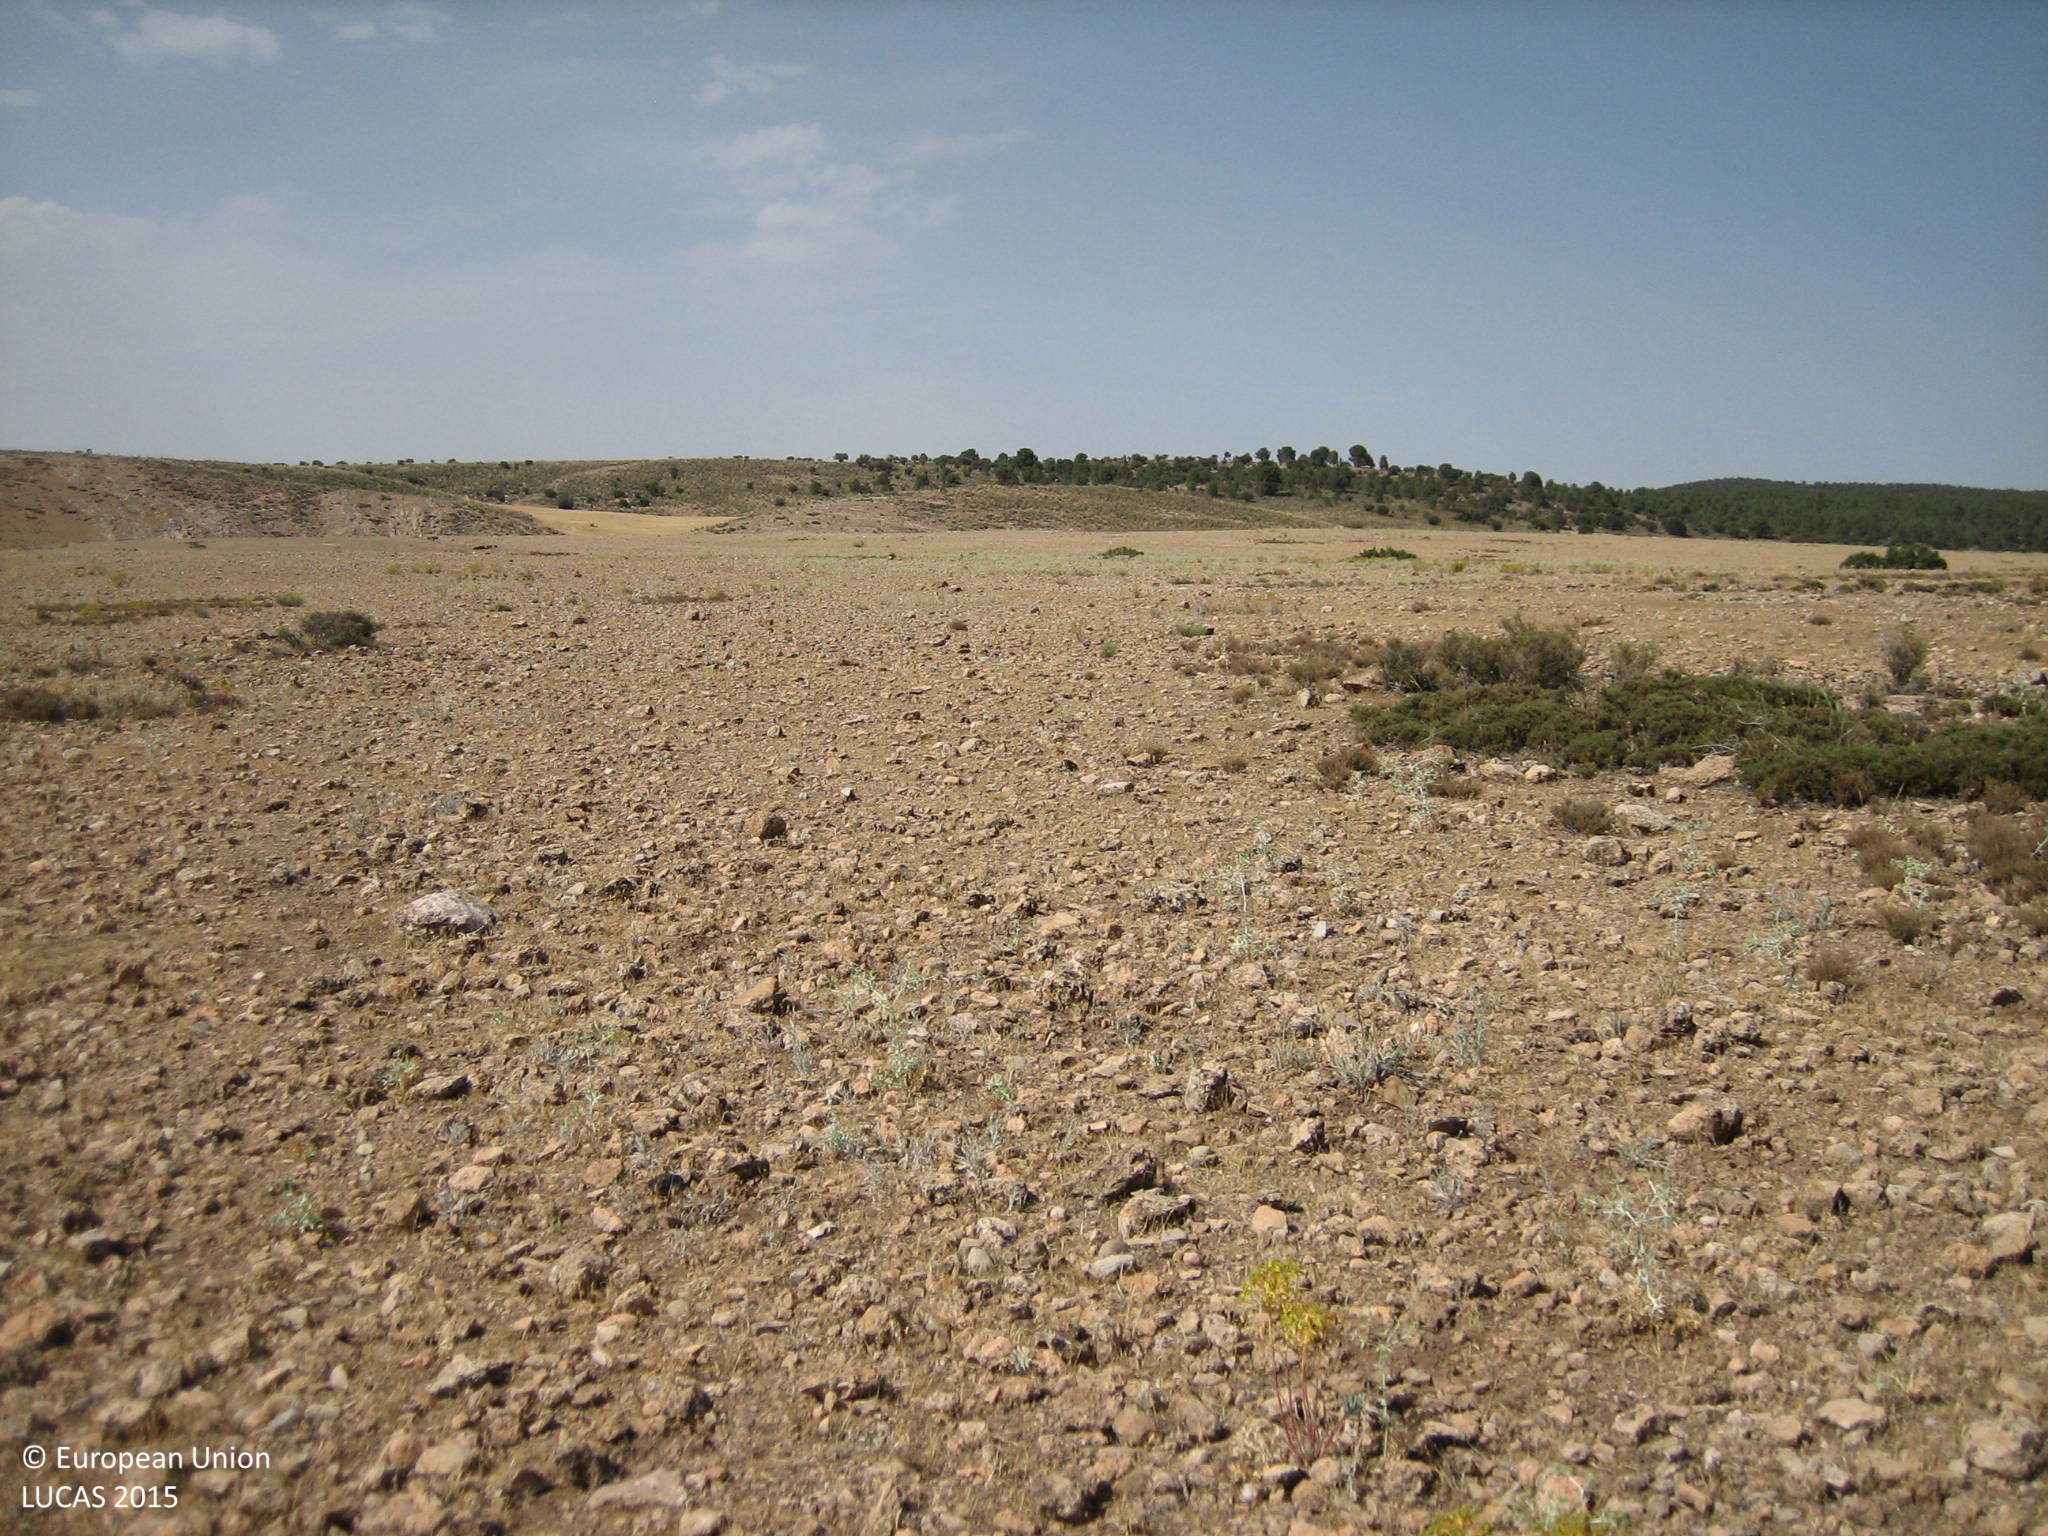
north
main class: Grassland
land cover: Grassland without tree/shrub cover
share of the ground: 10 - 25 %
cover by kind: unconsolidated bare surface 70 %, consolidated bare surface 15 %, herbaceous plants 10 %, shrubs 5 %
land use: Agriculture (excluding fallow land and kitchen gardens)
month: July
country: ES
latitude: 37.7009
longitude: -2.2698
